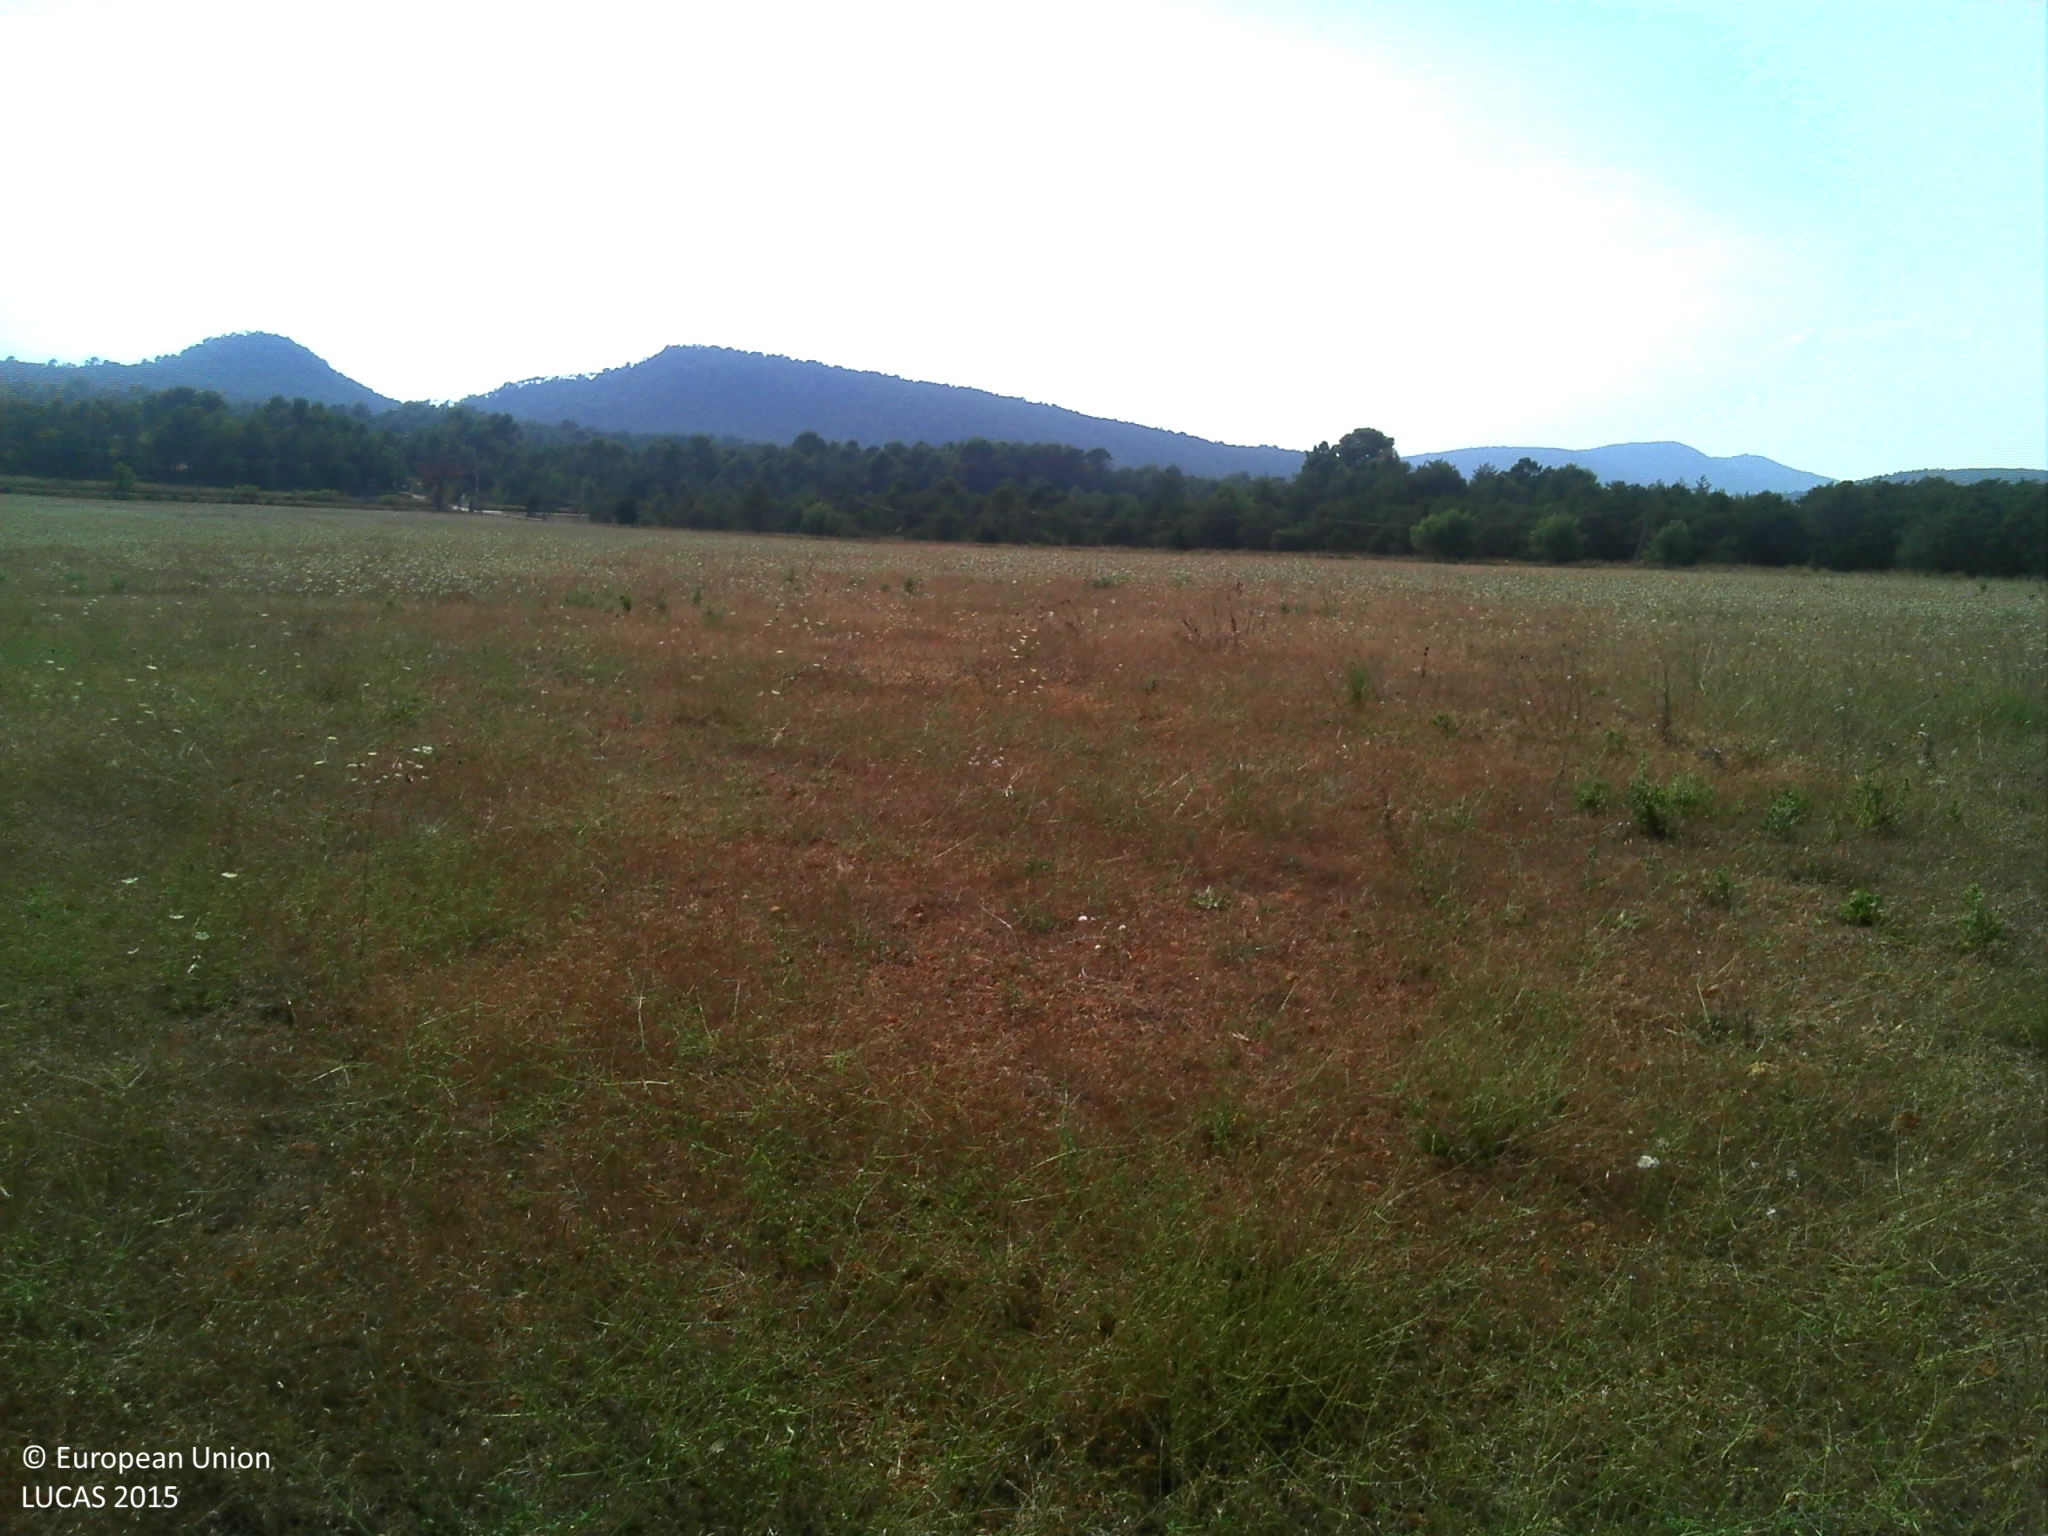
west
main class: Cropland
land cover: Temporary grasslands
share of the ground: > 75 %
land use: Agriculture (excluding fallow land and kitchen gardens)
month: August
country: FR
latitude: 43.6183
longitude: 6.3529
